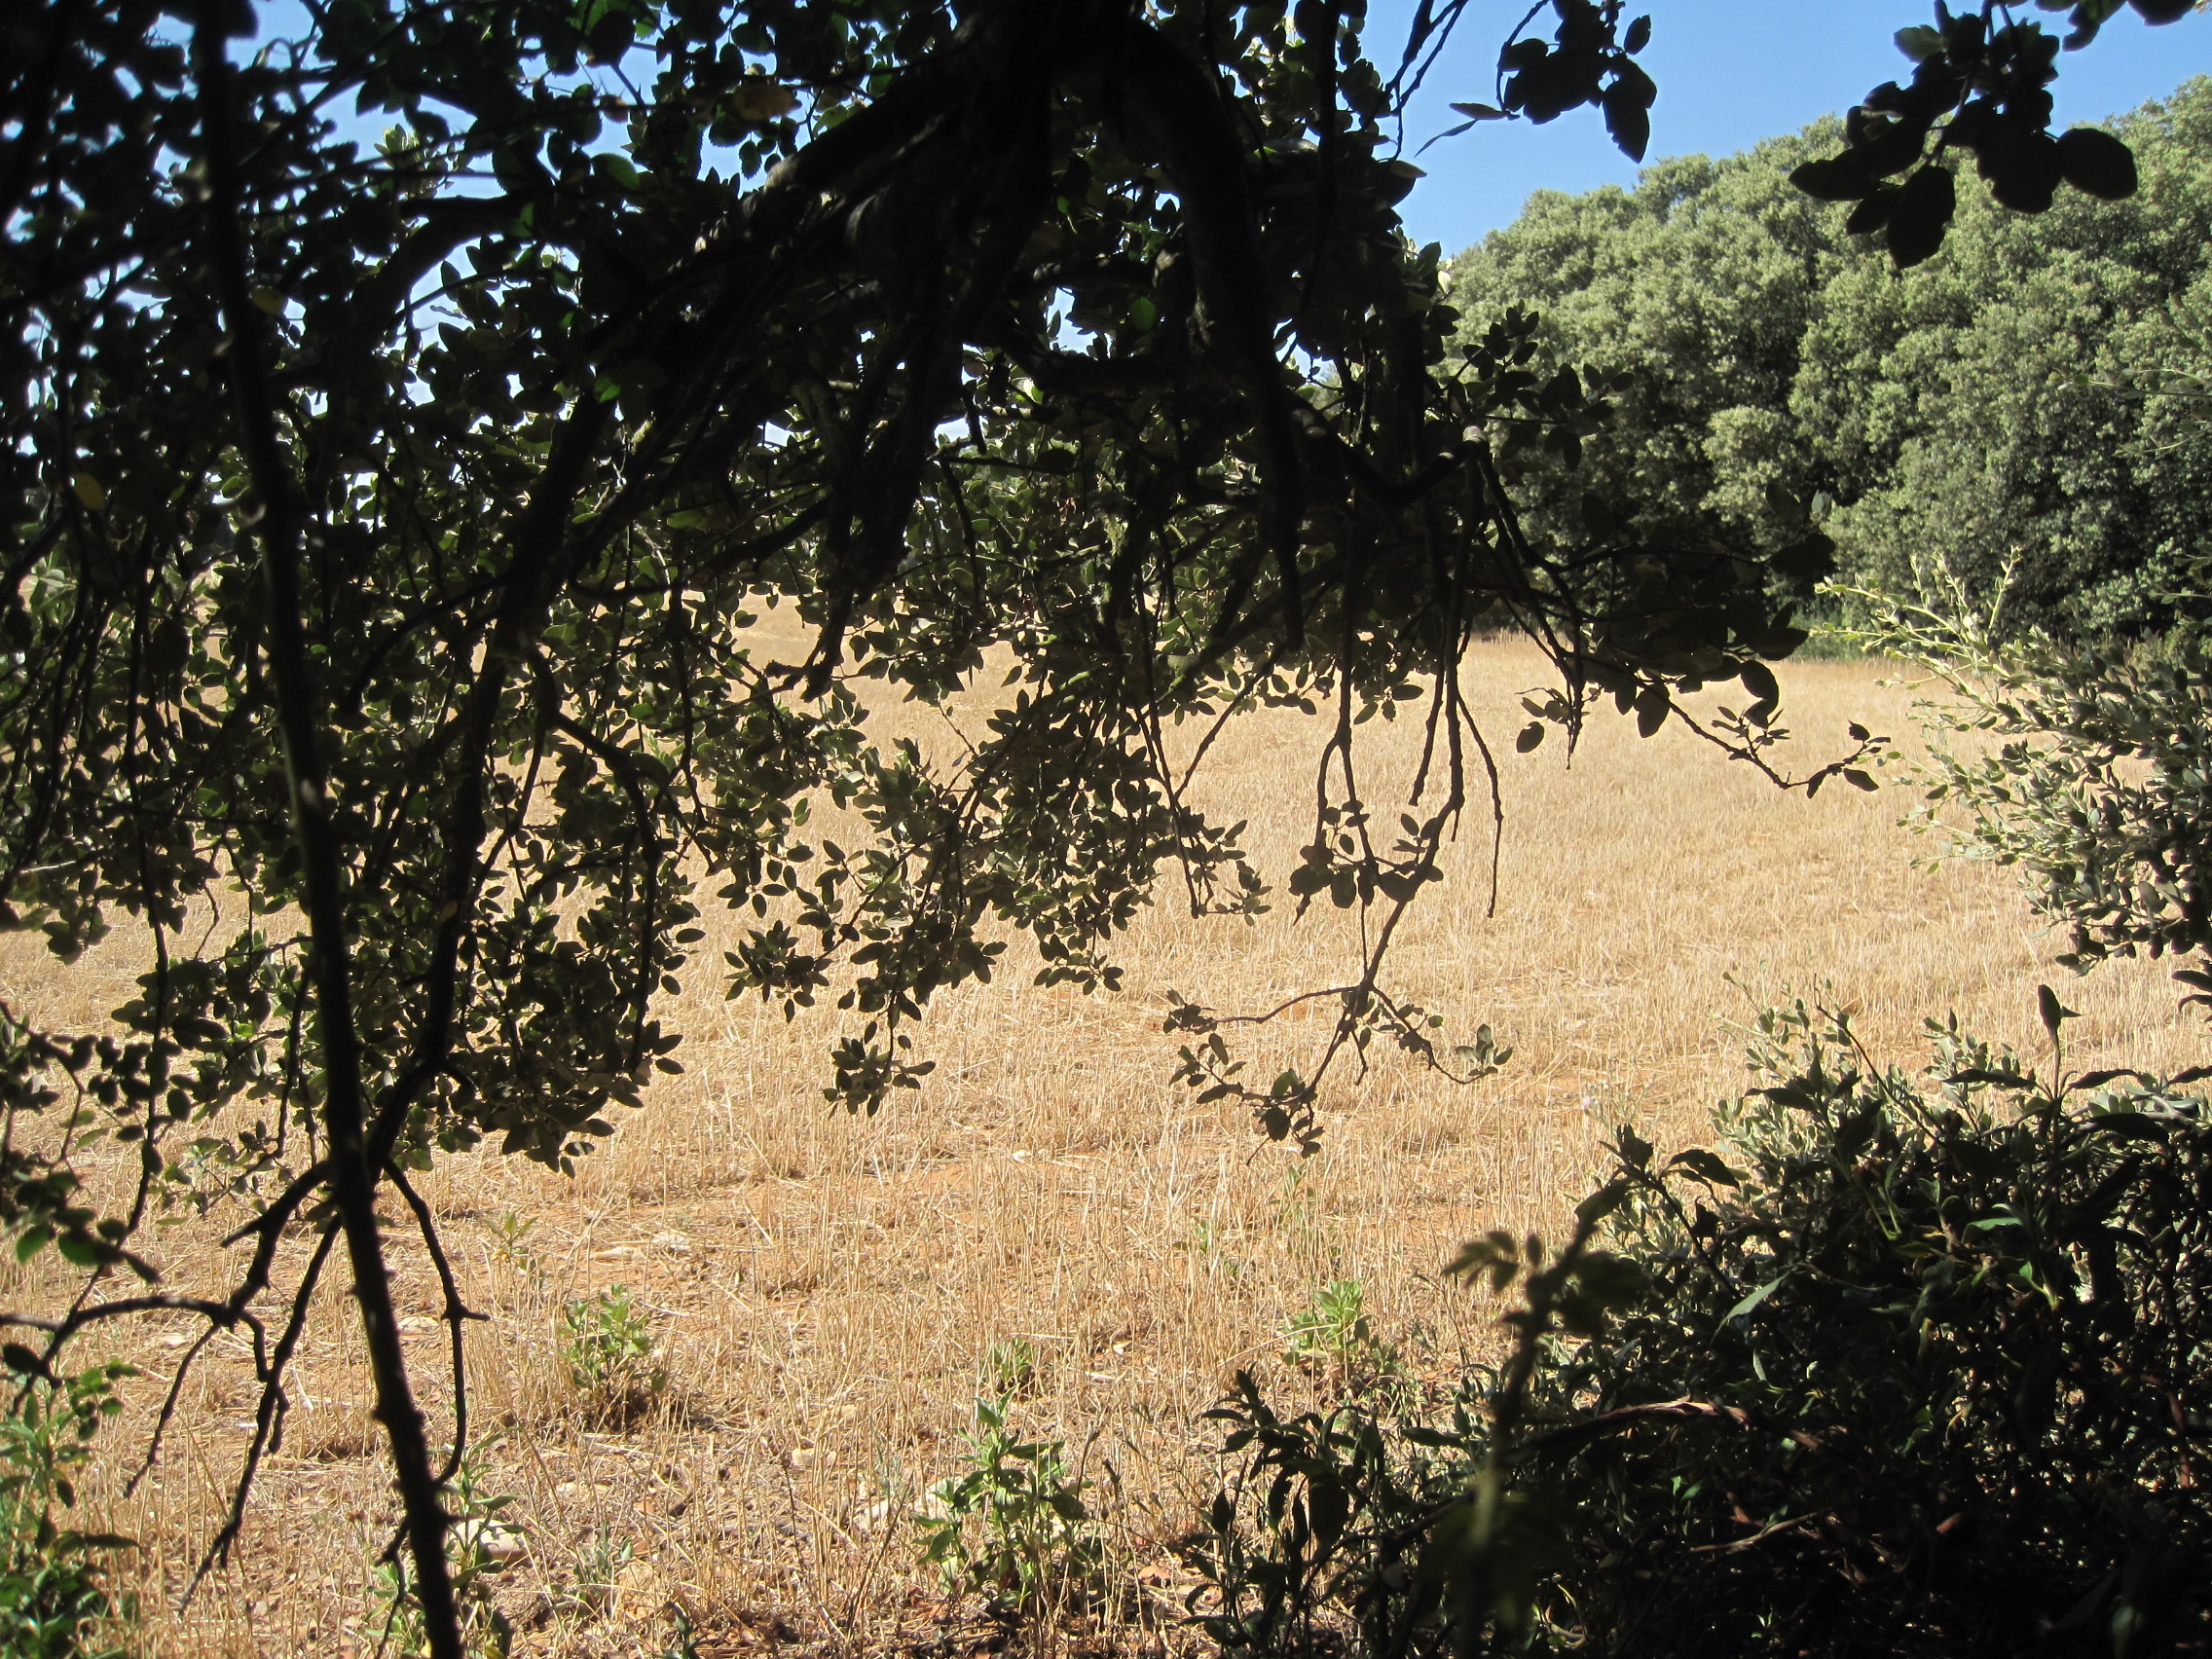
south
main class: Woodland
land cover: Broadleaved woodland
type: thermophilous deciduous forest
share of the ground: > 75 %
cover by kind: broadleaved forest trees 75 %, herbaceous plants 25 %
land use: Forestry
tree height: > 5 m
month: July
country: ES
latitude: 41.8913
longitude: -4.6664
